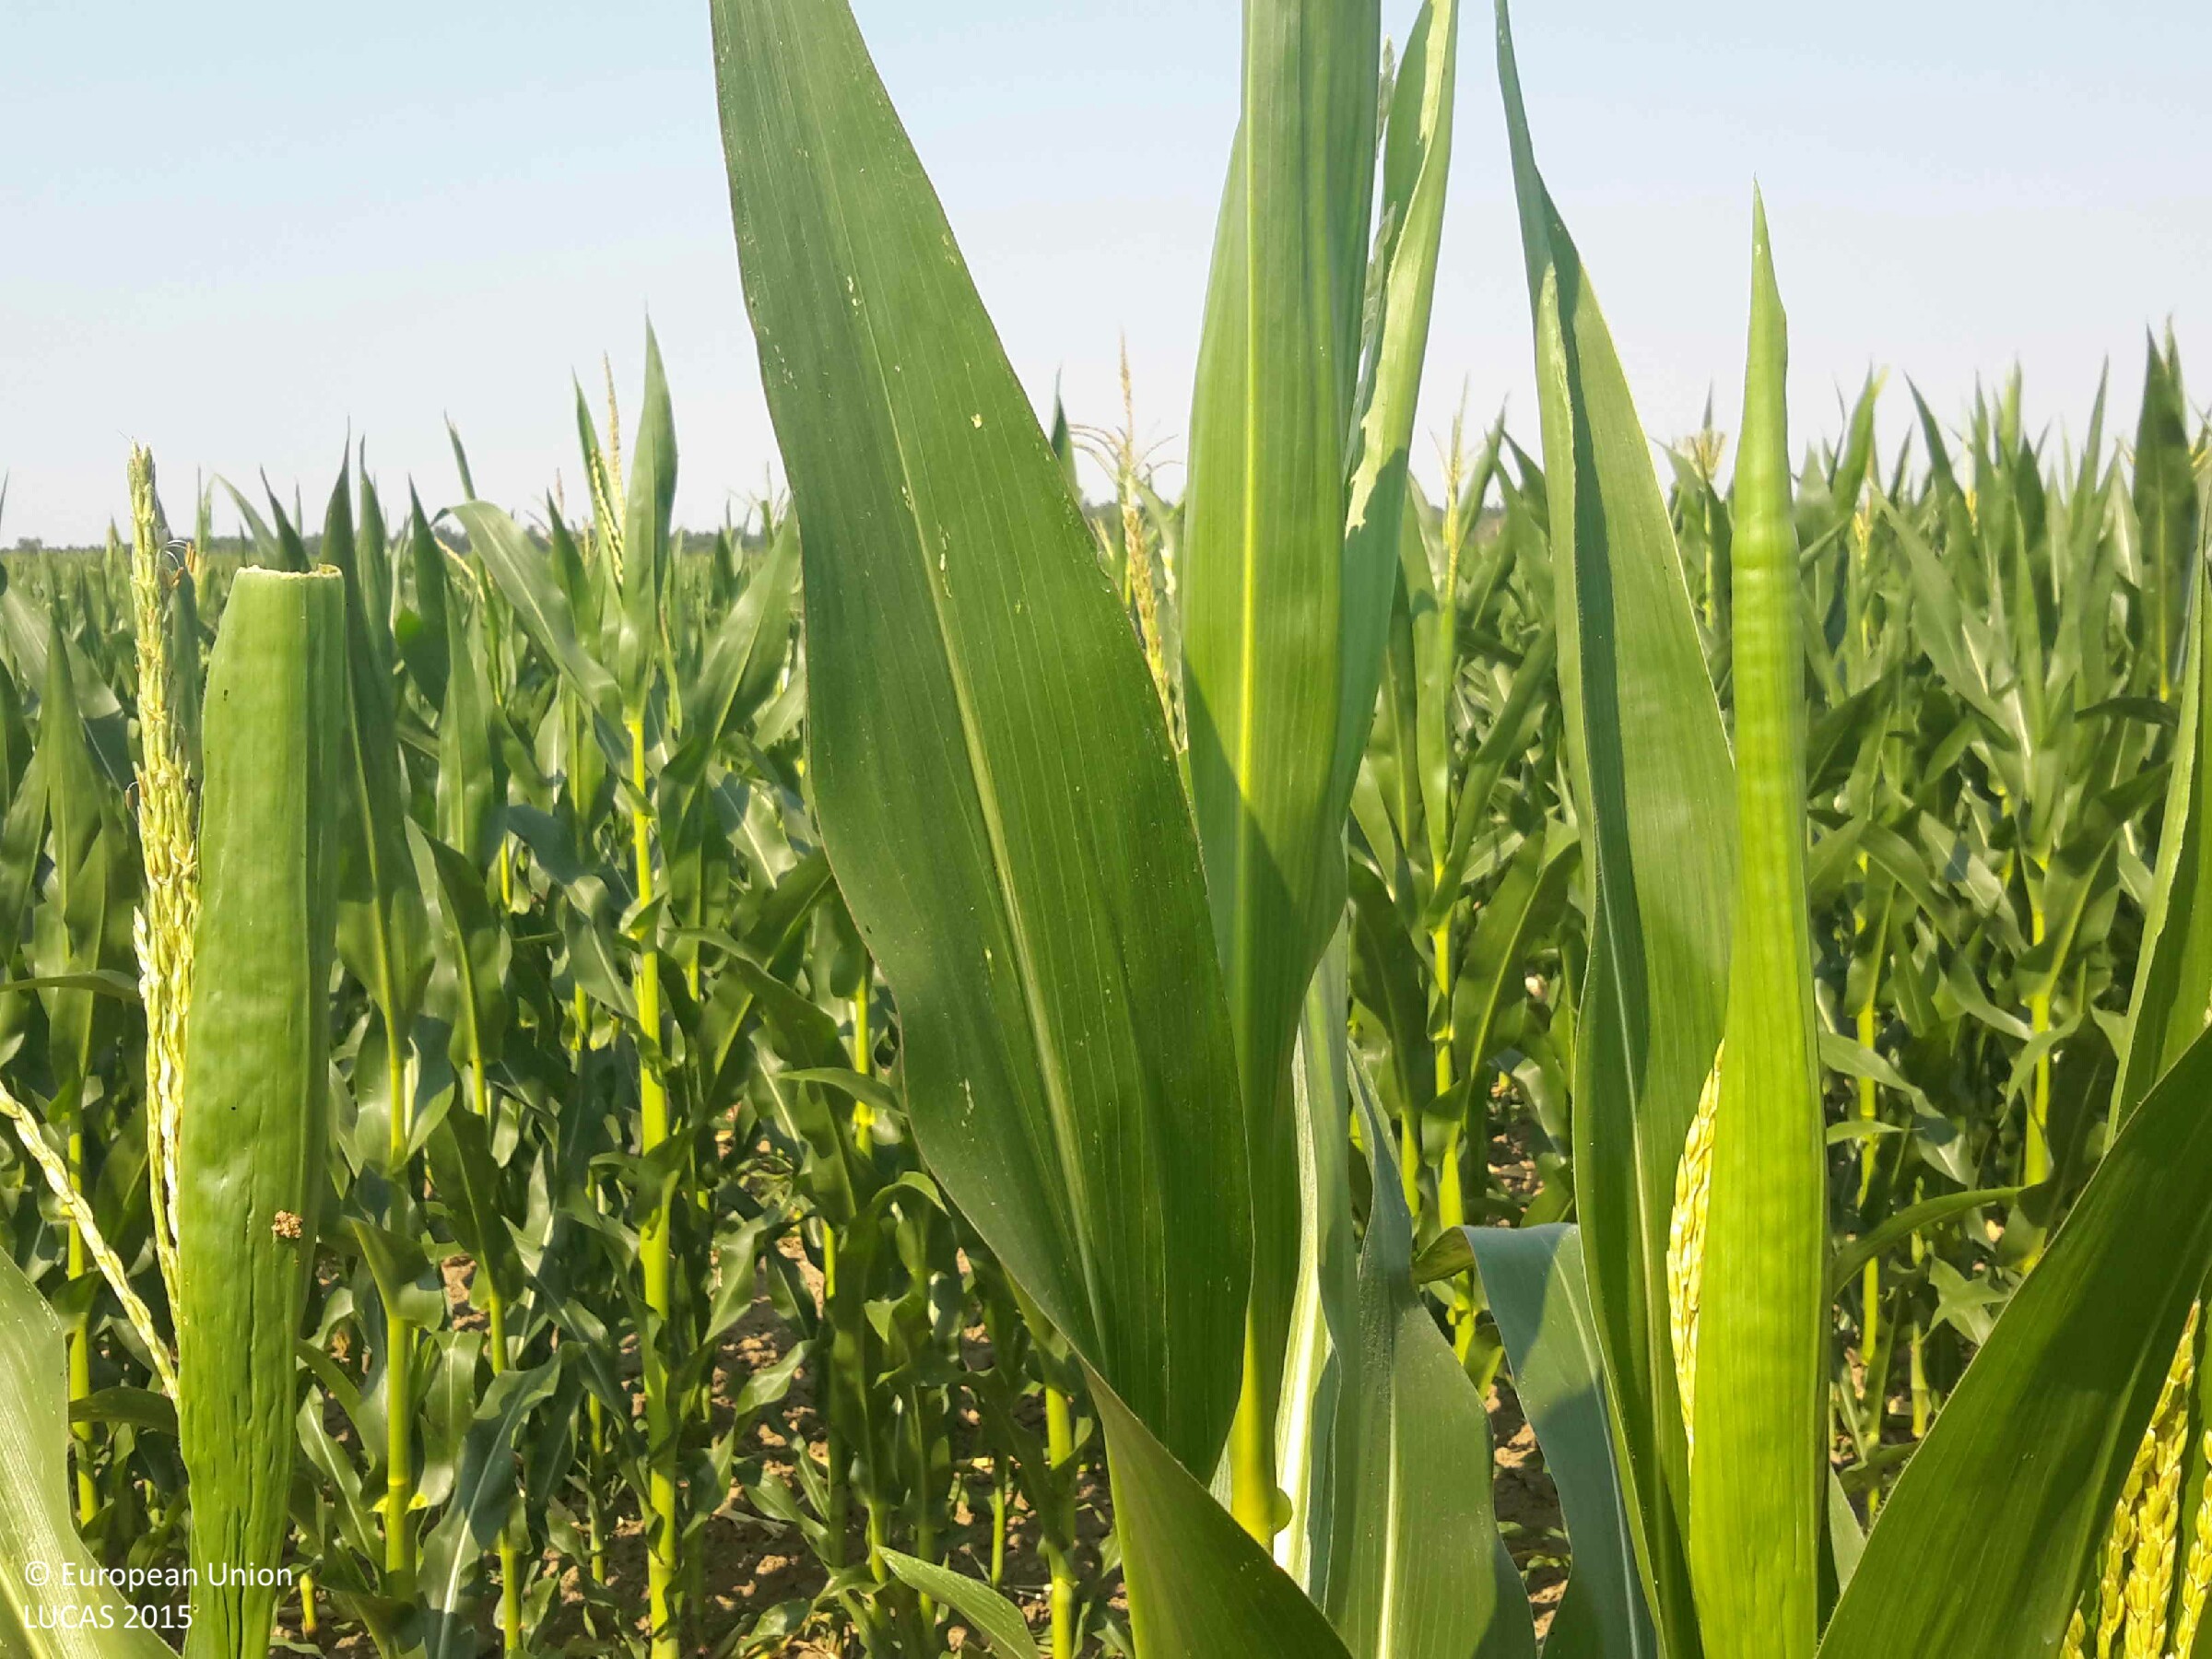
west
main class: Cropland
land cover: Maize
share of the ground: > 75 %
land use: Agriculture (excluding fallow land and kitchen gardens)
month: July
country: HU
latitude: 47.2127
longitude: 17.1752
